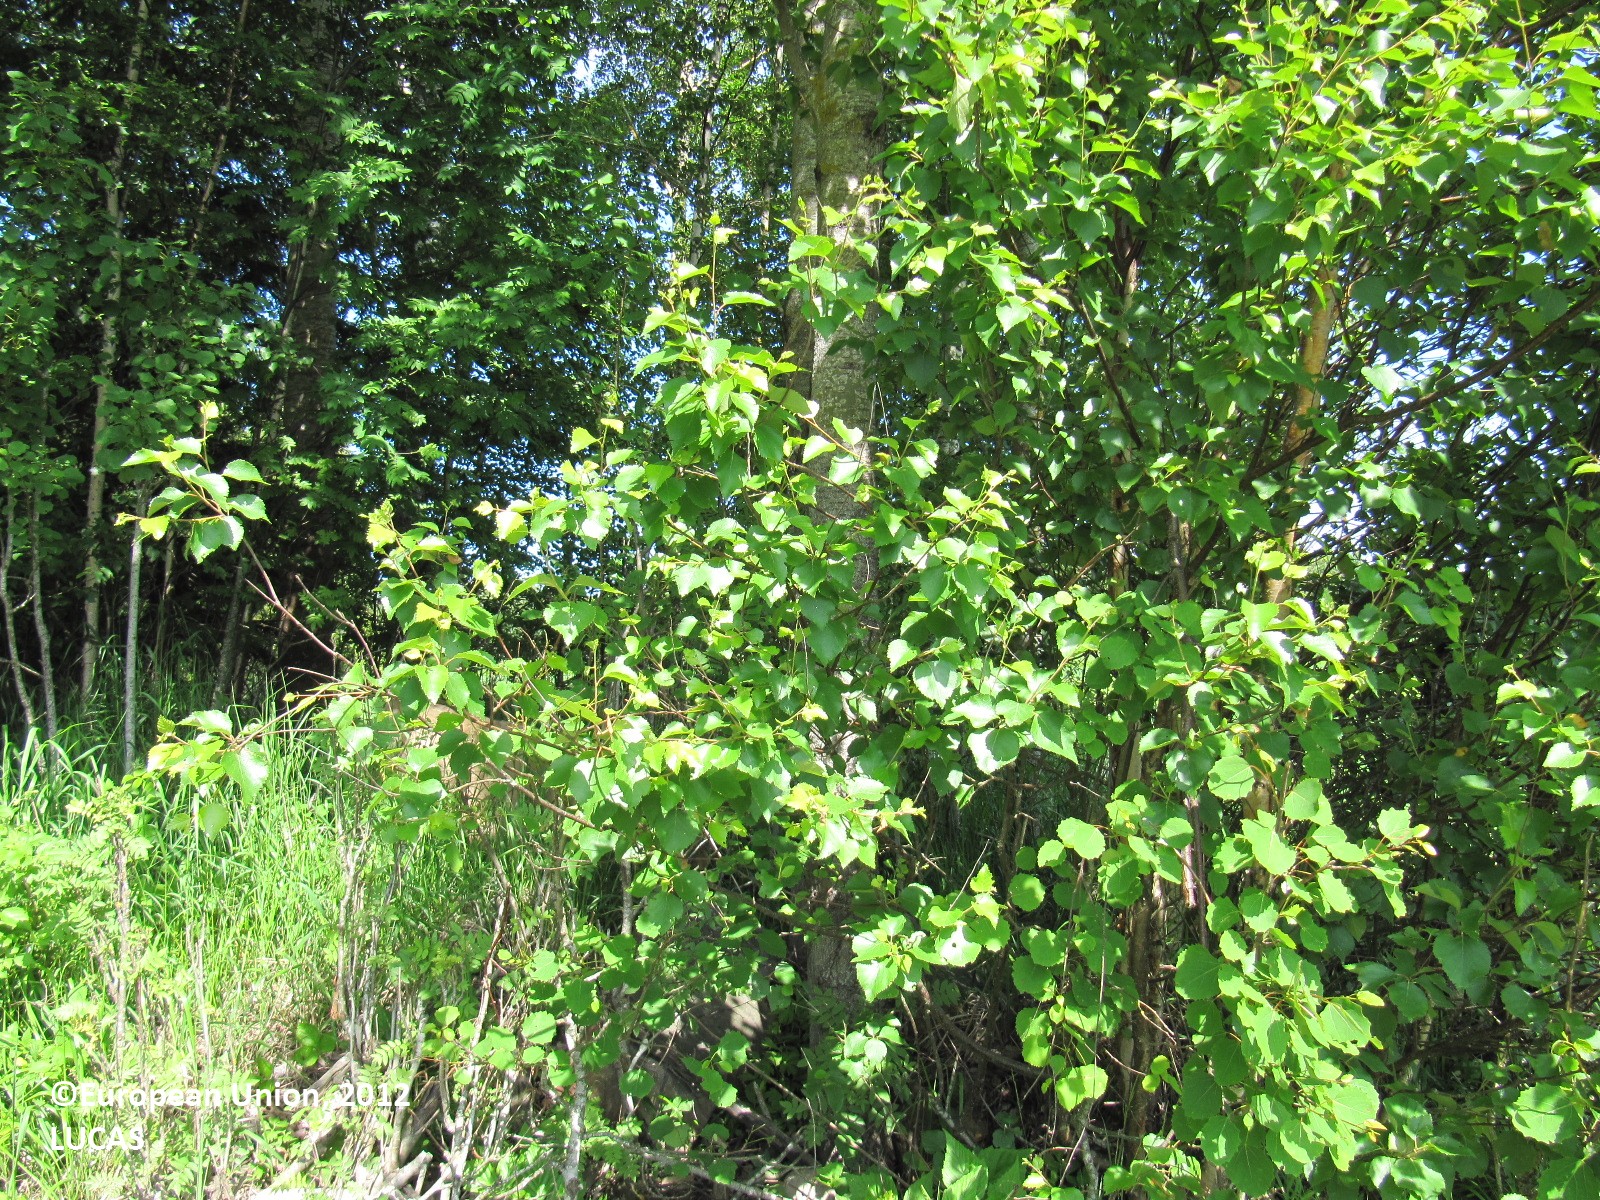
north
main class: Cropland
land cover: Sugar beet
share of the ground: 50 - 75 %
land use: Agriculture (excluding fallow land and kitchen gardens)
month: June
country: FI
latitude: 59.9667
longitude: 22.9233
